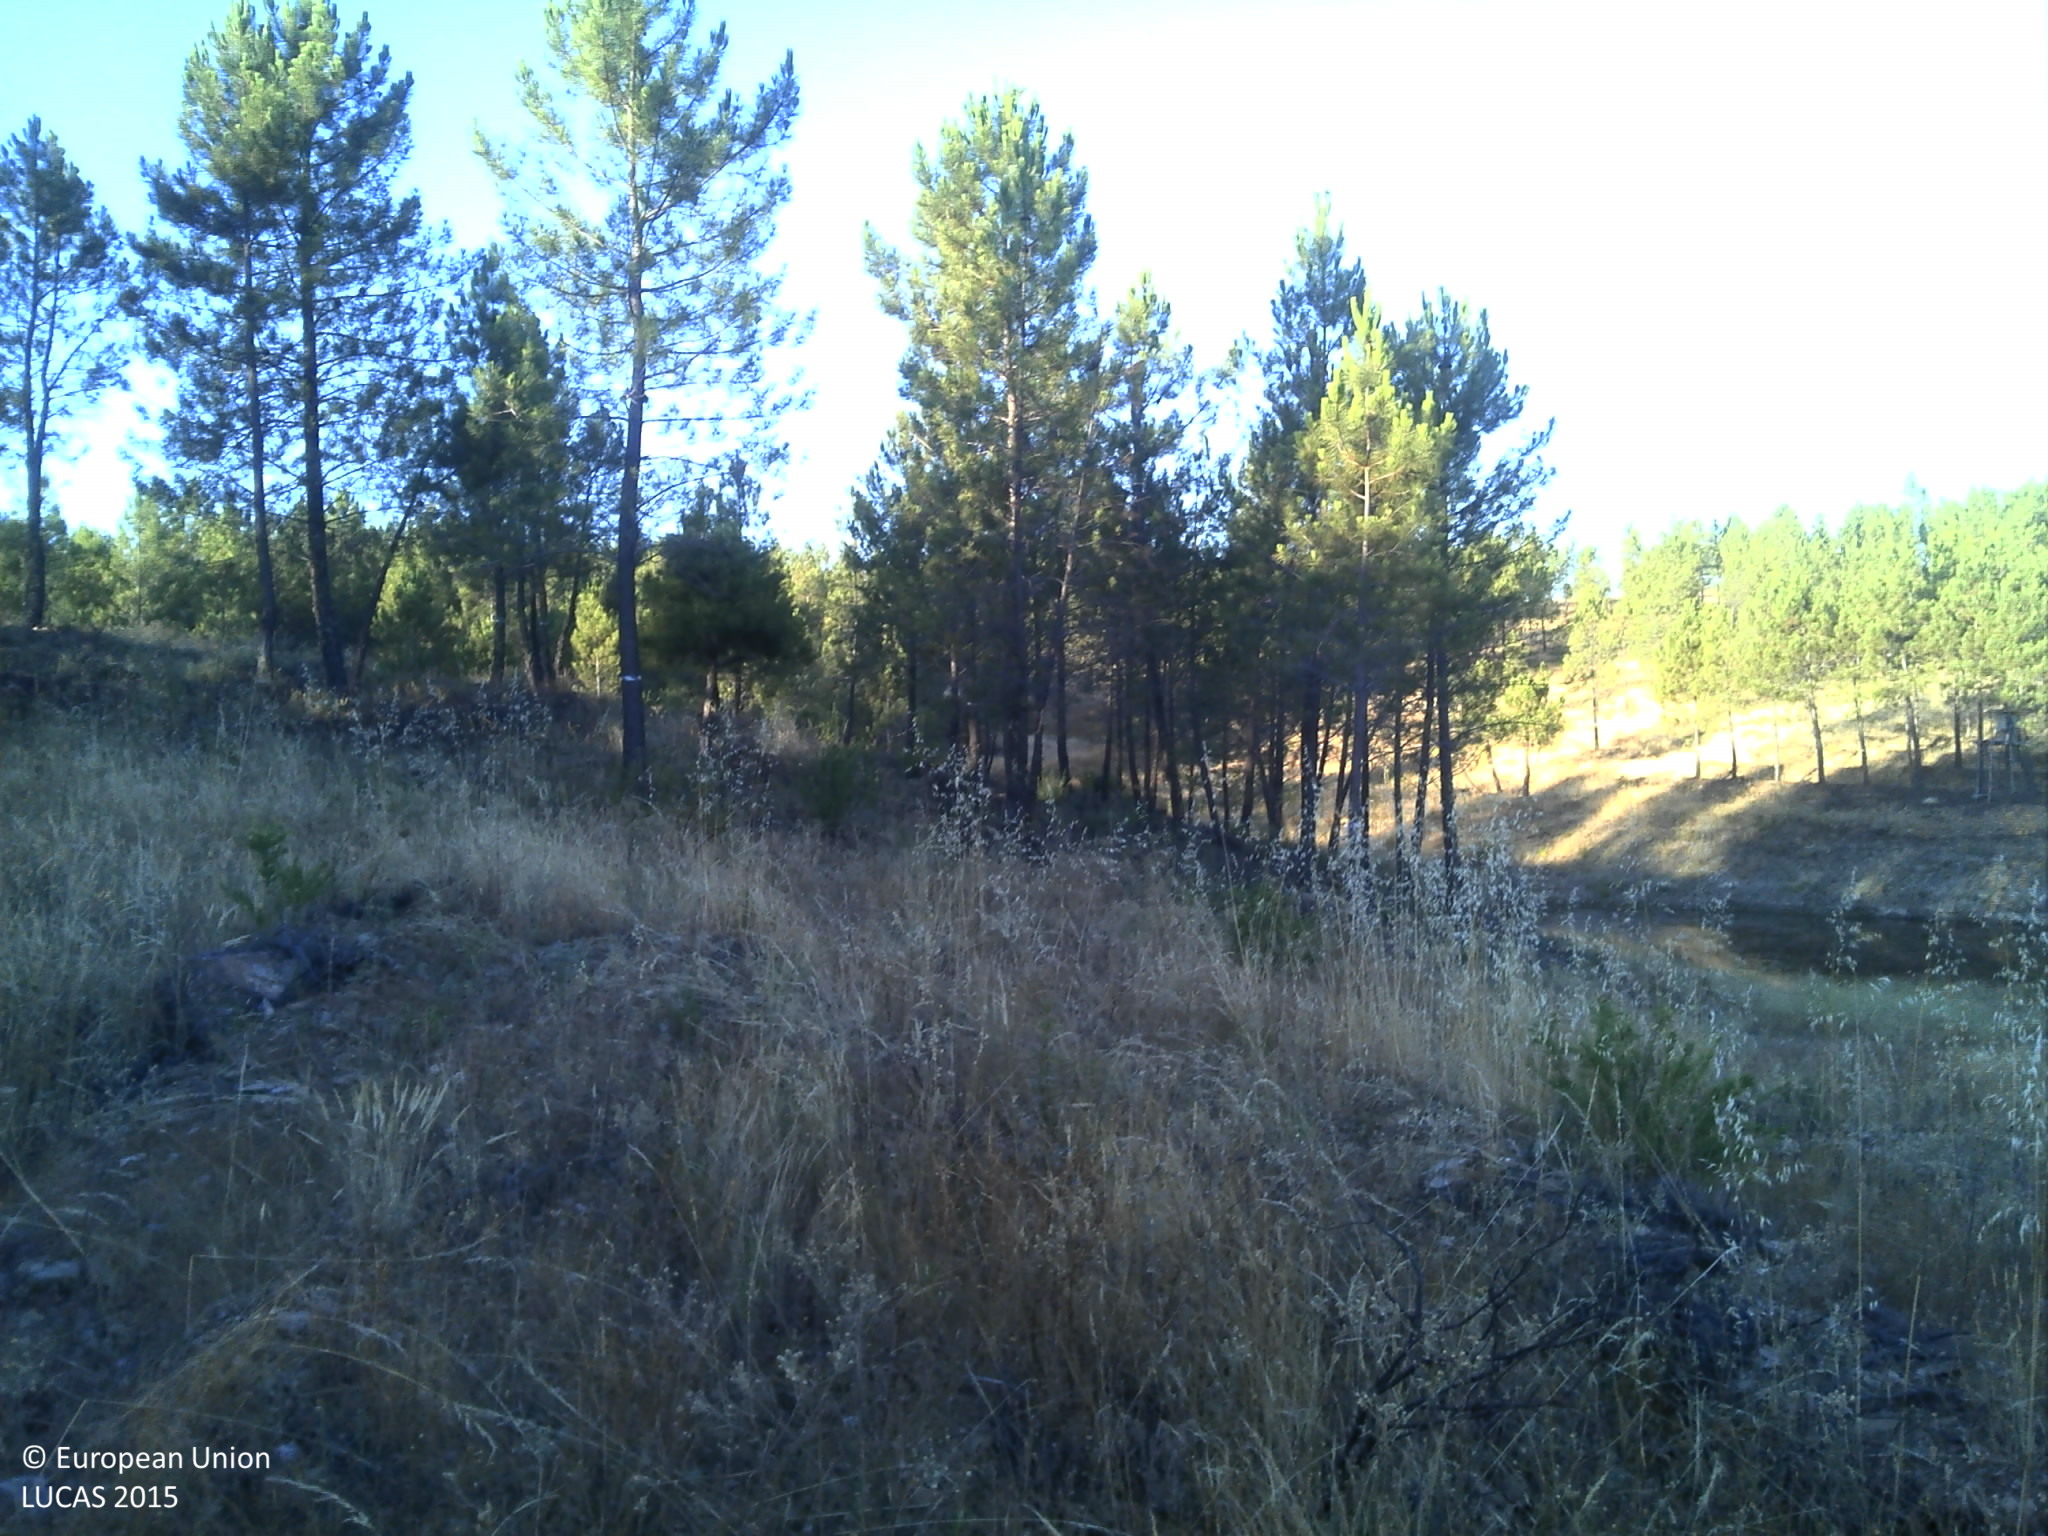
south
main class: Woodland
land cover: Pine dominated coniferous woodland
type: coniferous forest of the mediterranean region
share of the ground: 10 - 25 %
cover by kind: unconsolidated bare surface 30 %, coniferous forest trees 25 %, herbaceous plants 25 %, shrubs 20 %
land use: Forestry
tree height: > 5 m
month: July
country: PT
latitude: 39.9580
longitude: -7.5808
